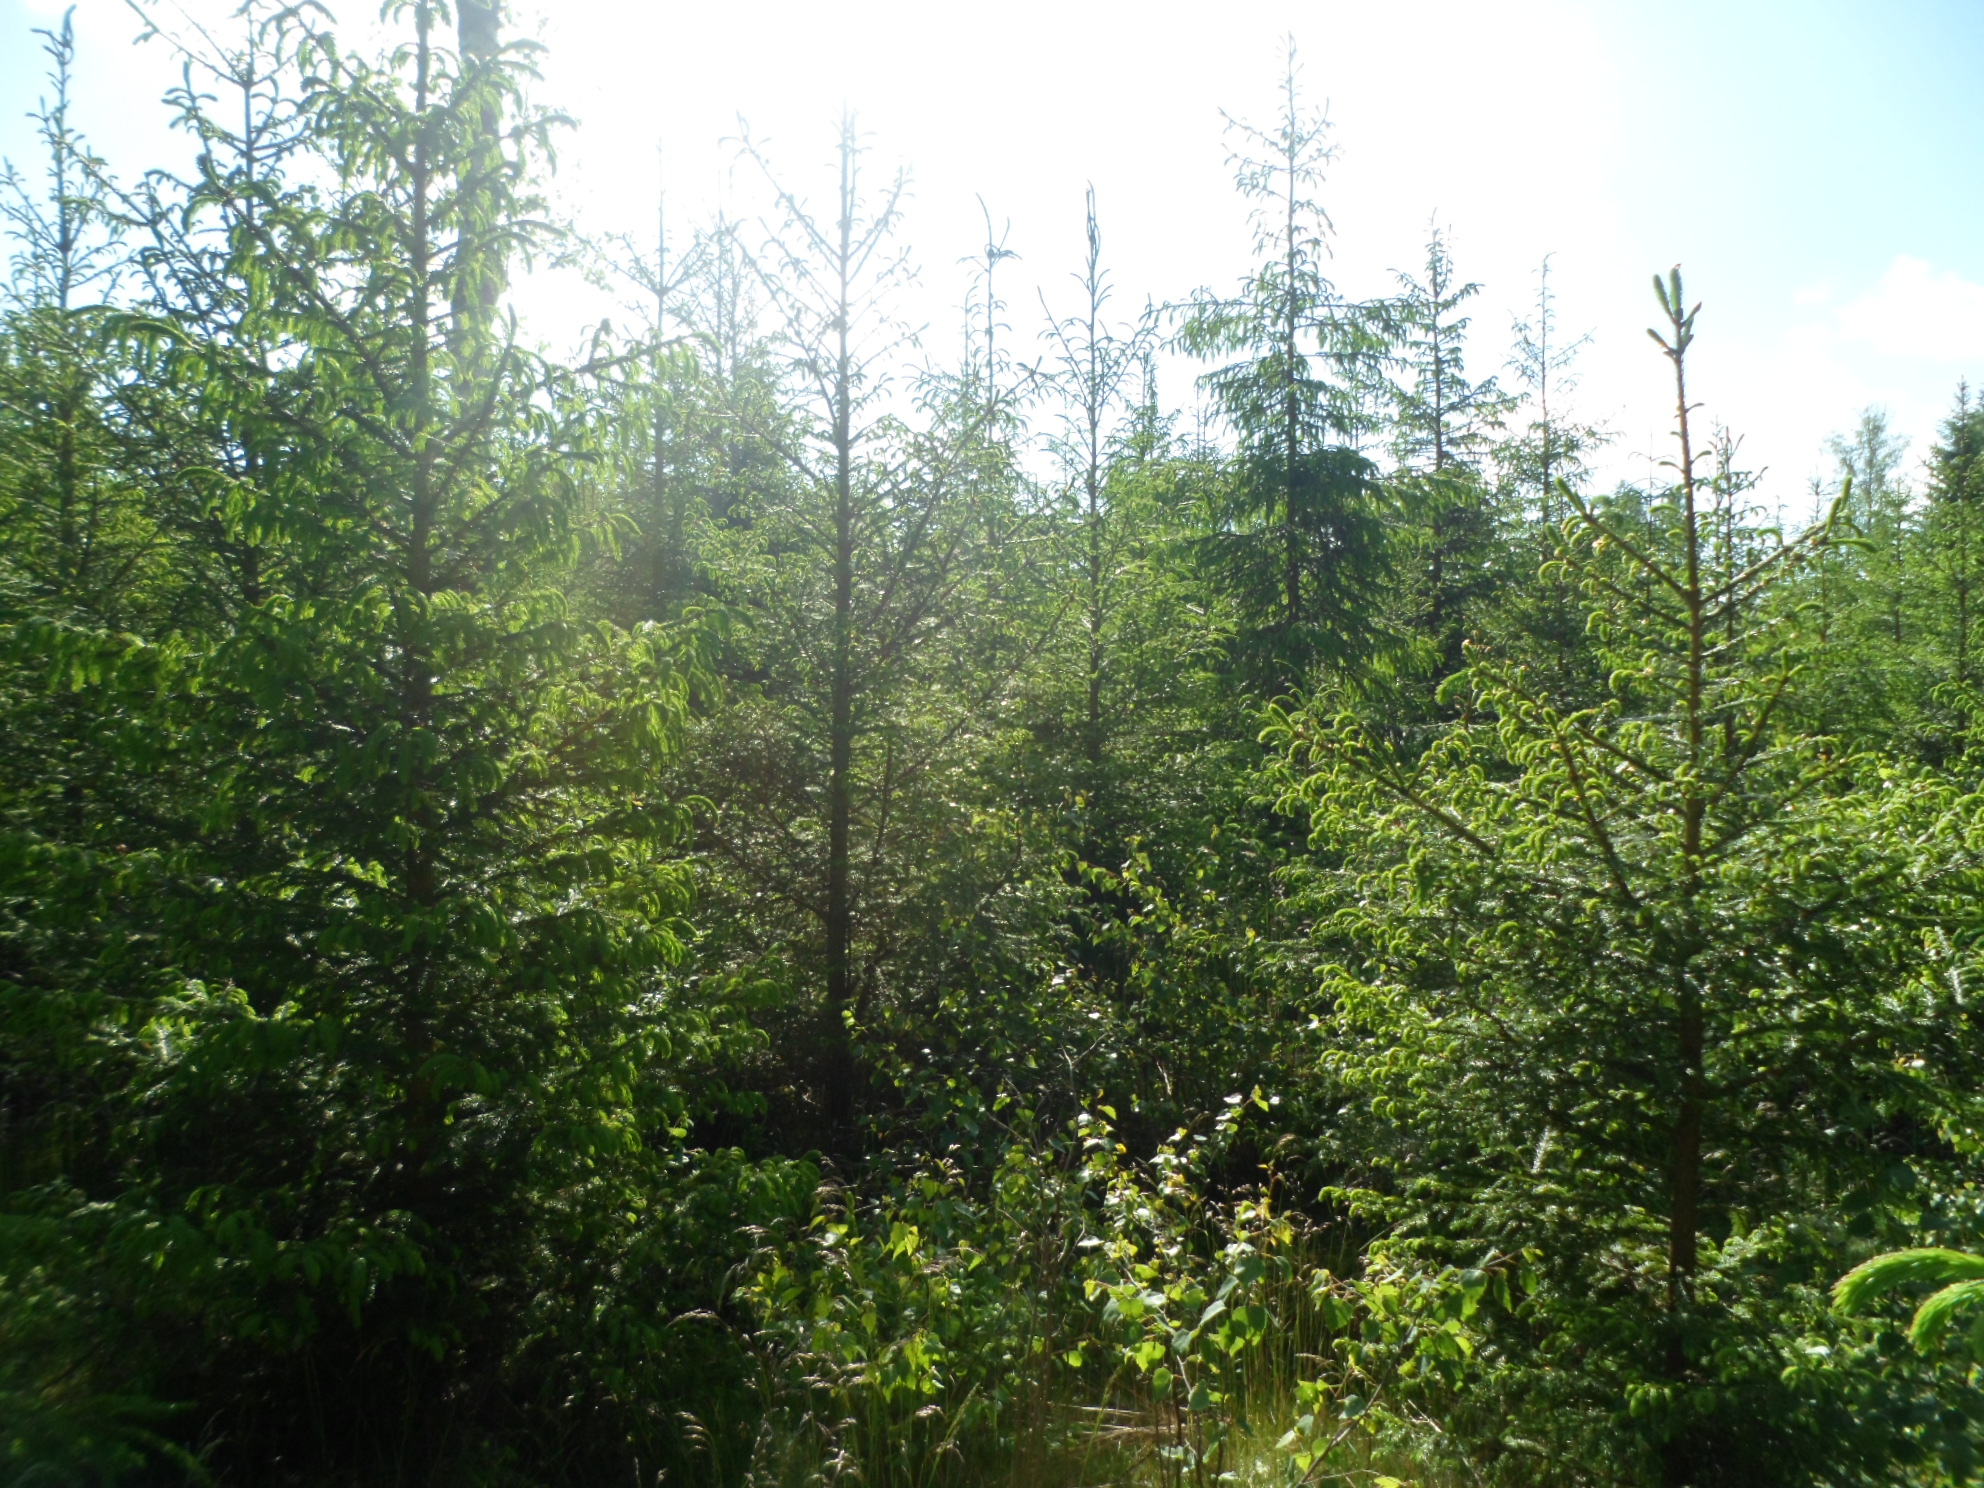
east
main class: Woodland
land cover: Spruce dominated mixed woodland
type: boreal forest
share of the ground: 50 - 75 %
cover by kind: coniferous forest trees 30 %, herbaceous plants 25 %, broadleaved forest trees 20 %, shrubs 20 %, lichens and mosses 5 %
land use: Forestry
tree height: < 5 m
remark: Clear cut
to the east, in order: Spruce dominated mixed woodland; Tracks; Spruce dominated mixed woodland; Tracks; Grass margins; Dry stone walls; Grassland without tree/shrub cover; Groves; Dry stone walls; Grassland without tree/shrub cover; Dry stone walls; Spruce dominated coniferous woodland; Dry stone walls; Broadleaved woodland
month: June
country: SE
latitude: 57.0852
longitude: 14.8975
